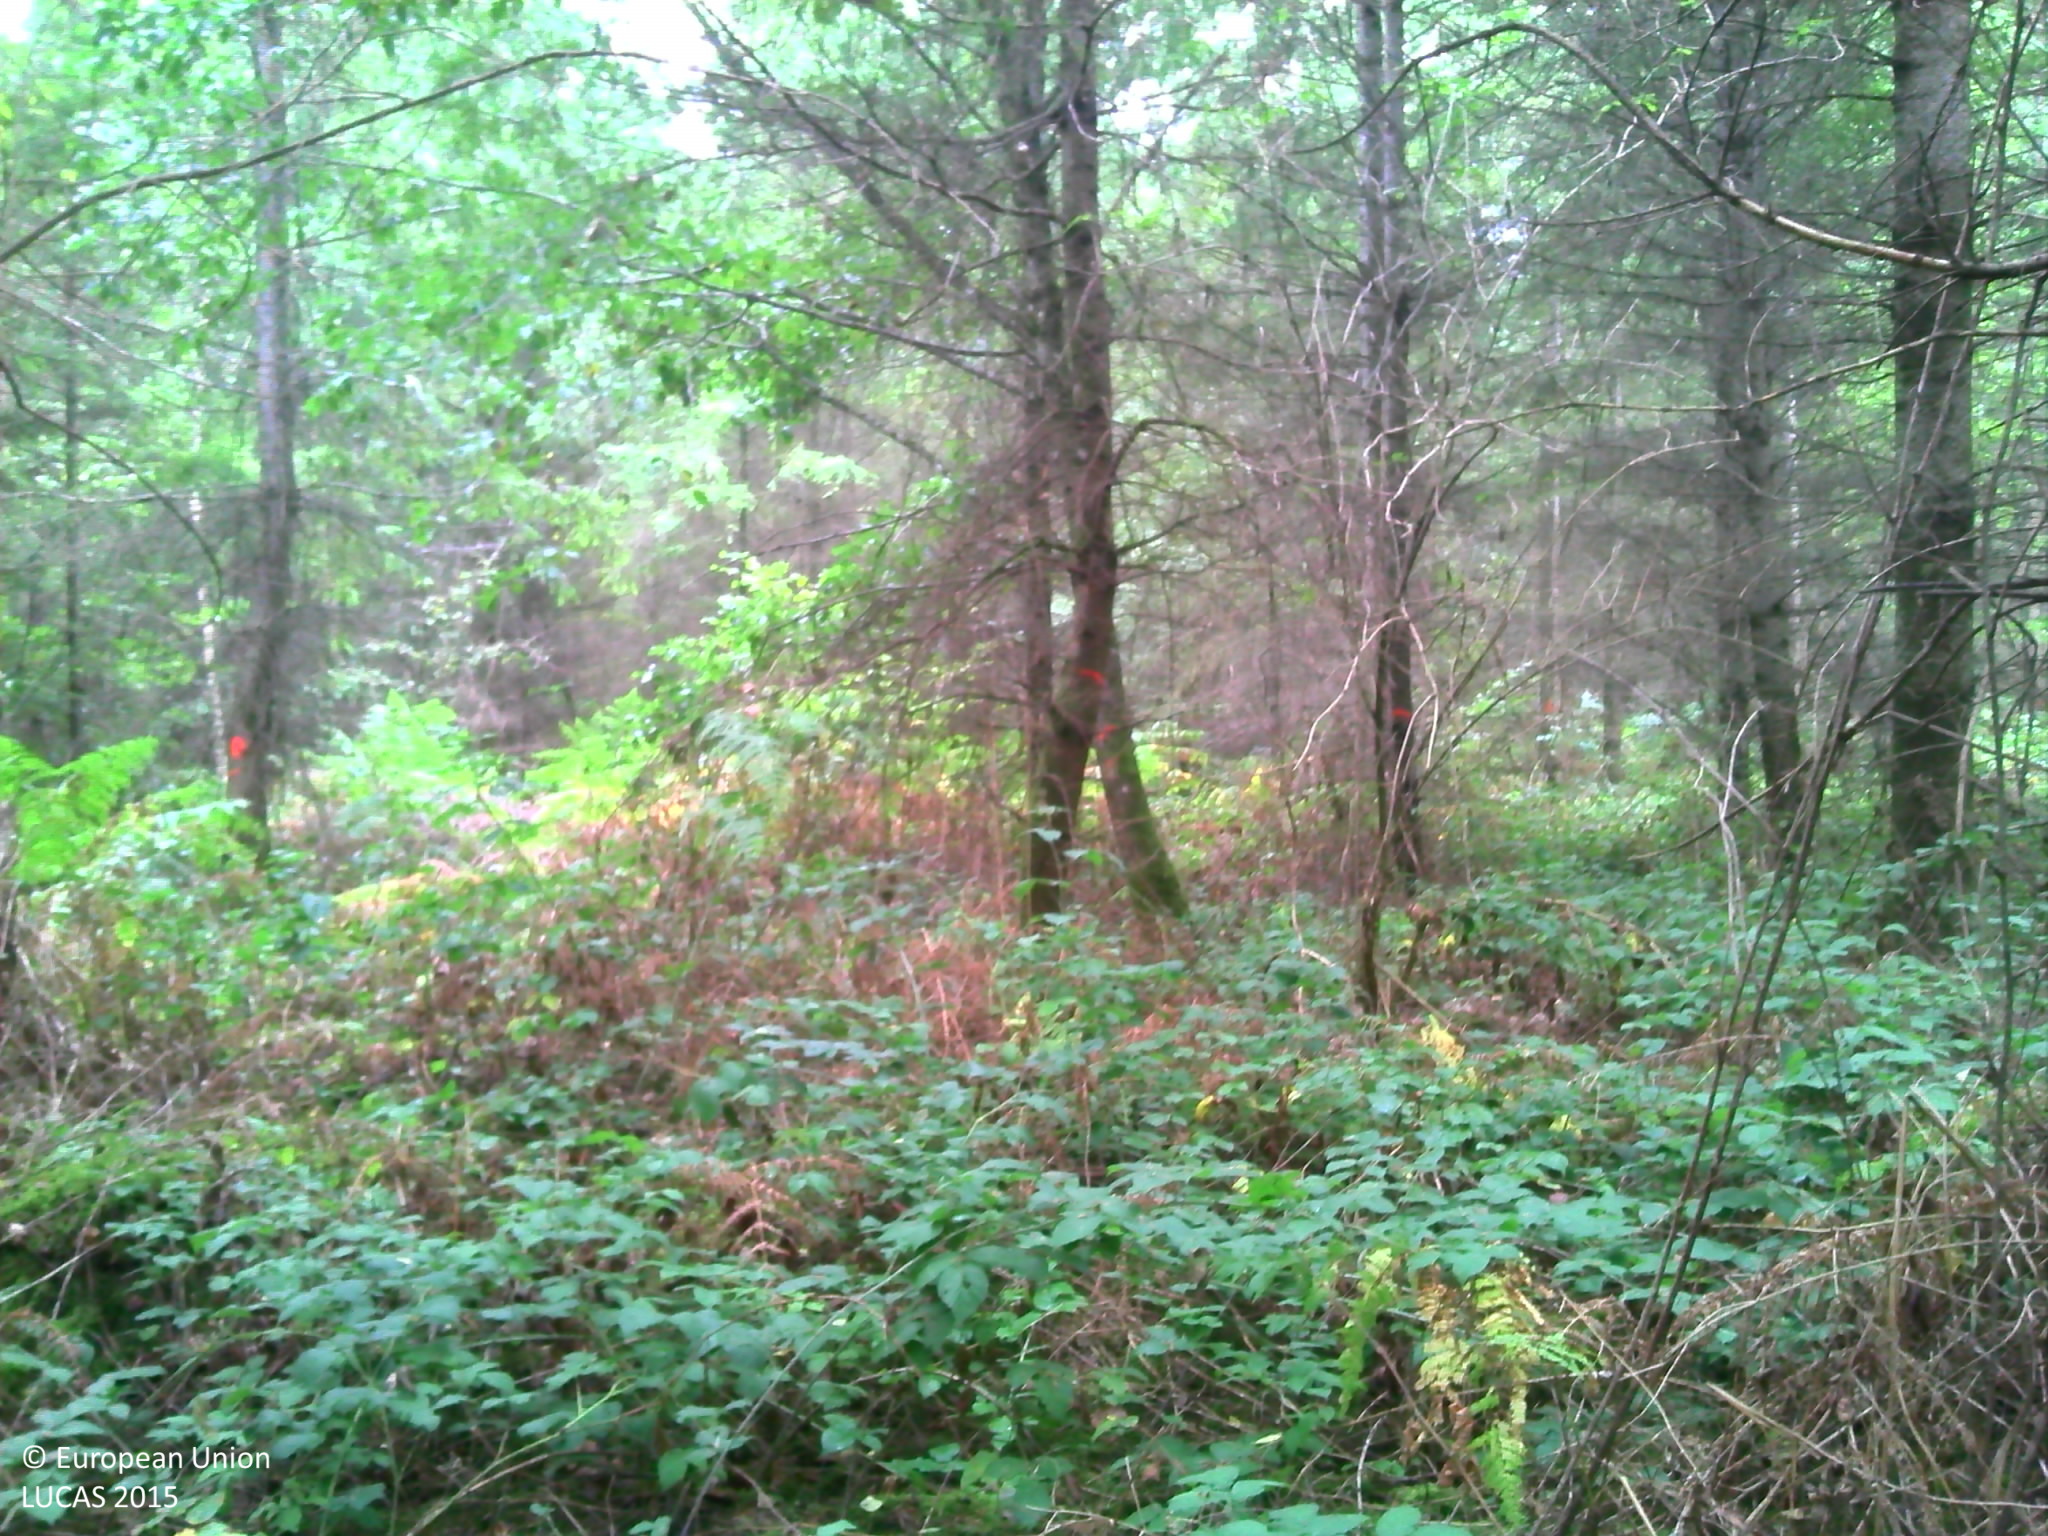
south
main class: Woodland
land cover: Other coniferous woodland
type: exotic forest
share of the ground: > 75 %
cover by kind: coniferous forest trees 80 %, broadleaved forest trees 10 %, shrubs 5 %, lichens and mosses 5 %
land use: Forestry
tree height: > 5 m
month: September
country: FR
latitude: 47.4465
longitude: 4.3360
